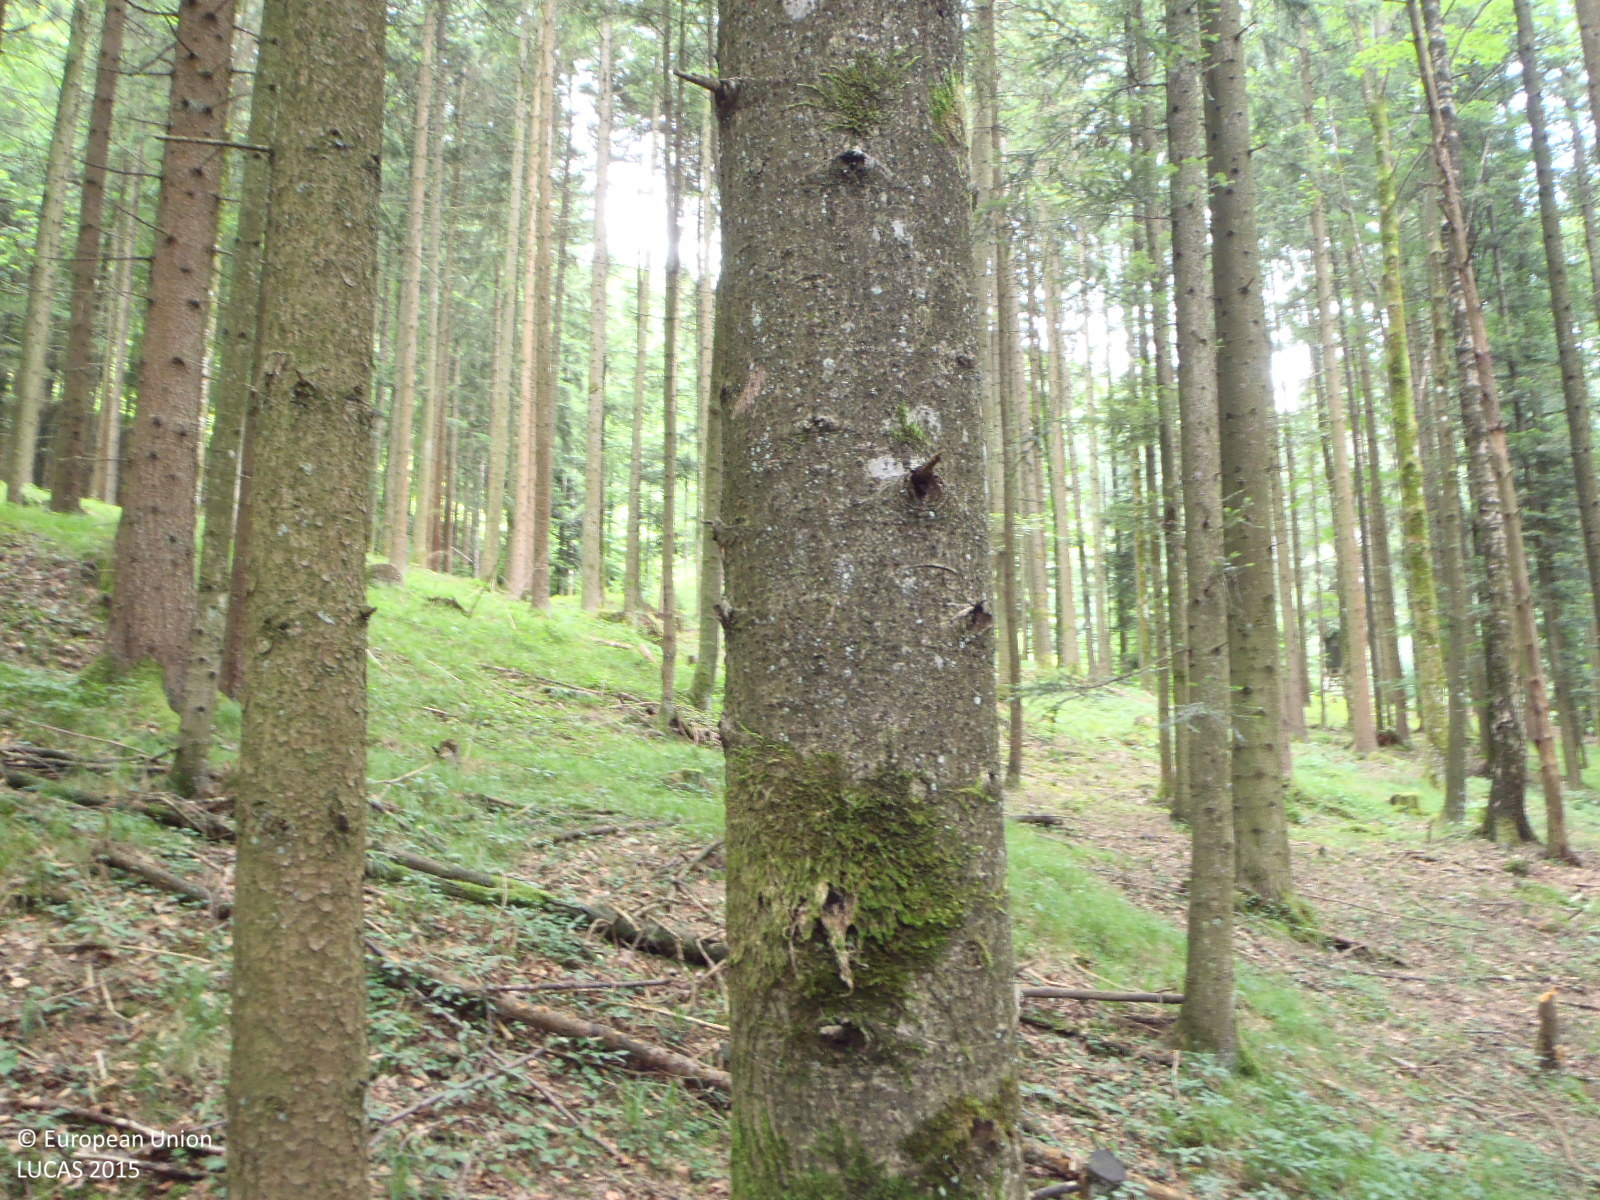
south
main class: Woodland
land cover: Spruce dominated coniferous woodland
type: alpine coniferous forest
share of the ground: > 75 %
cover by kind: coniferous forest trees 80 %, broadleaved forest trees 10 %, herbaceous plants 10 %
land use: Forestry
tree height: > 5 m
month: July
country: AT
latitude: 47.5896
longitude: 12.1926
